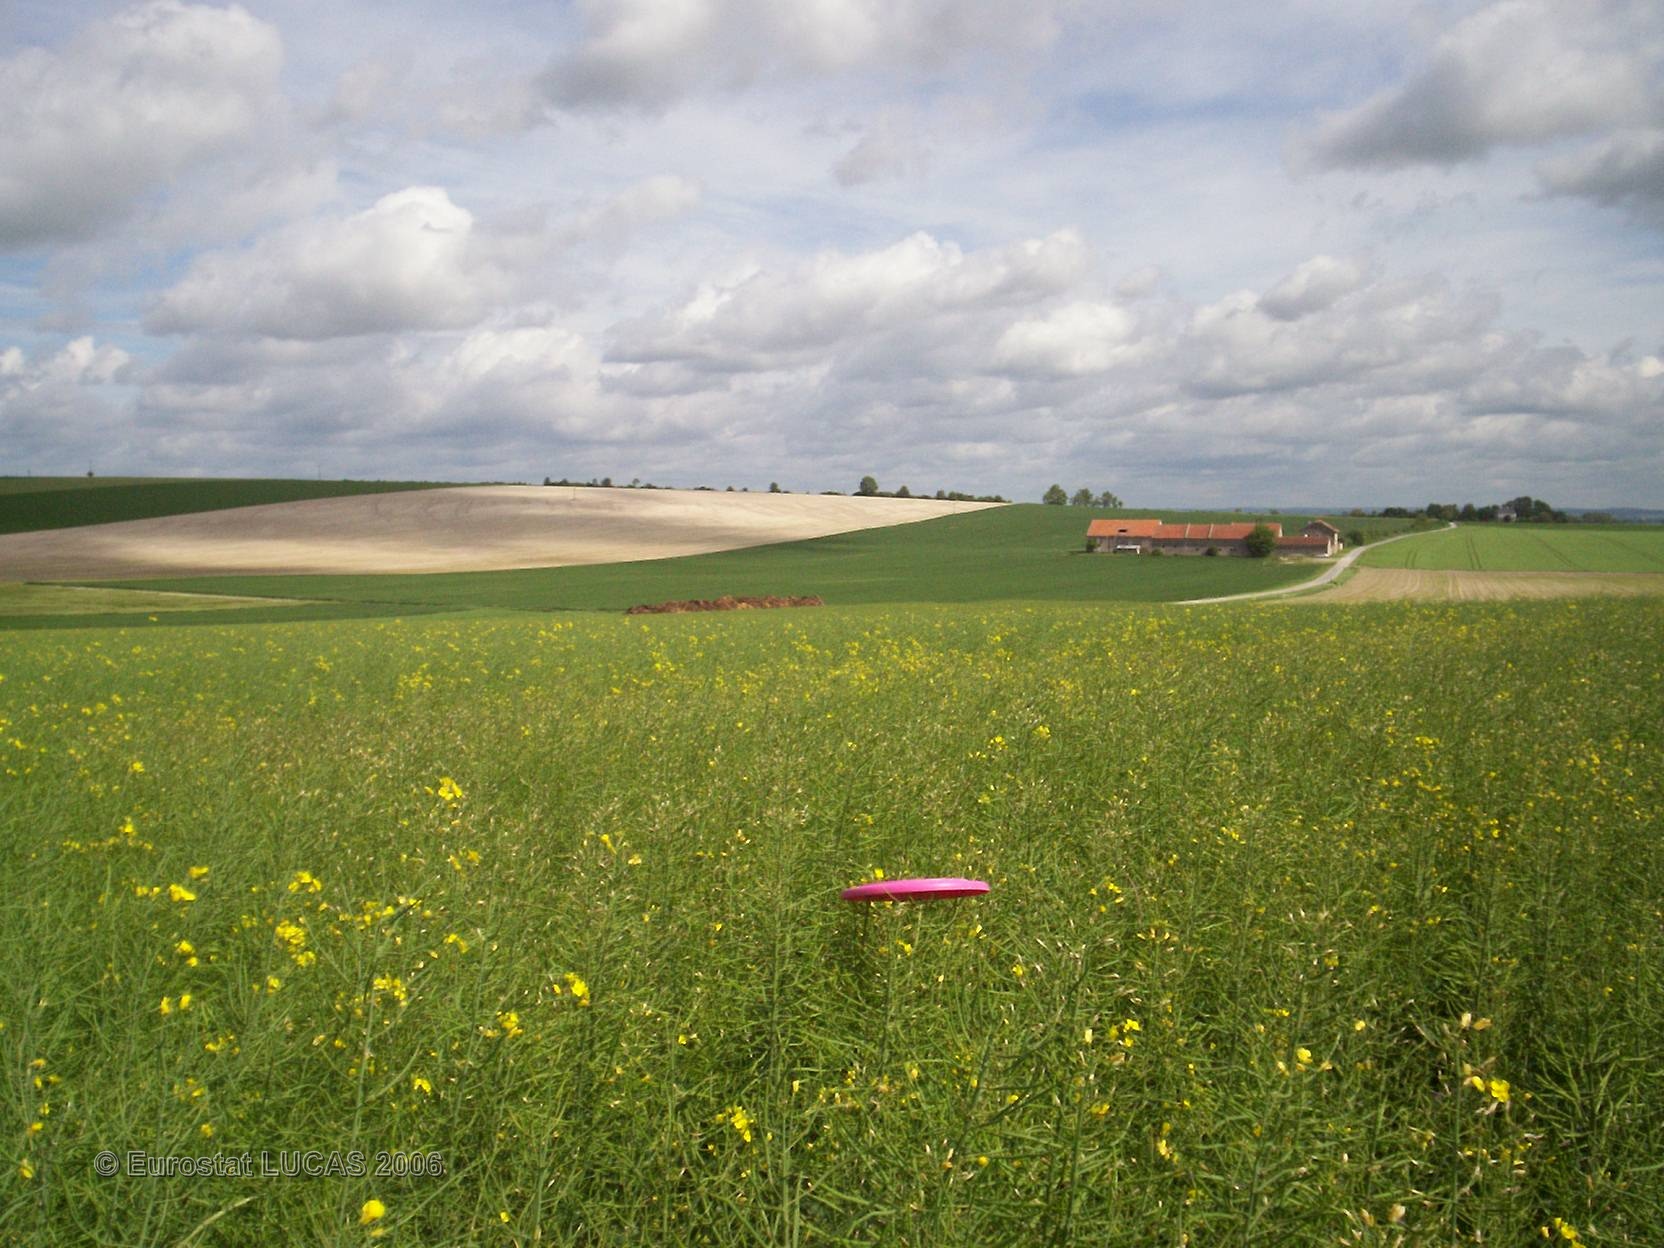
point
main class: Cropland
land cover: Rape and turnip rape
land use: Agriculture (excluding fallow land and kitchen gardens)
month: May
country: FR
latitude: 49.4715
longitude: 4.4347
